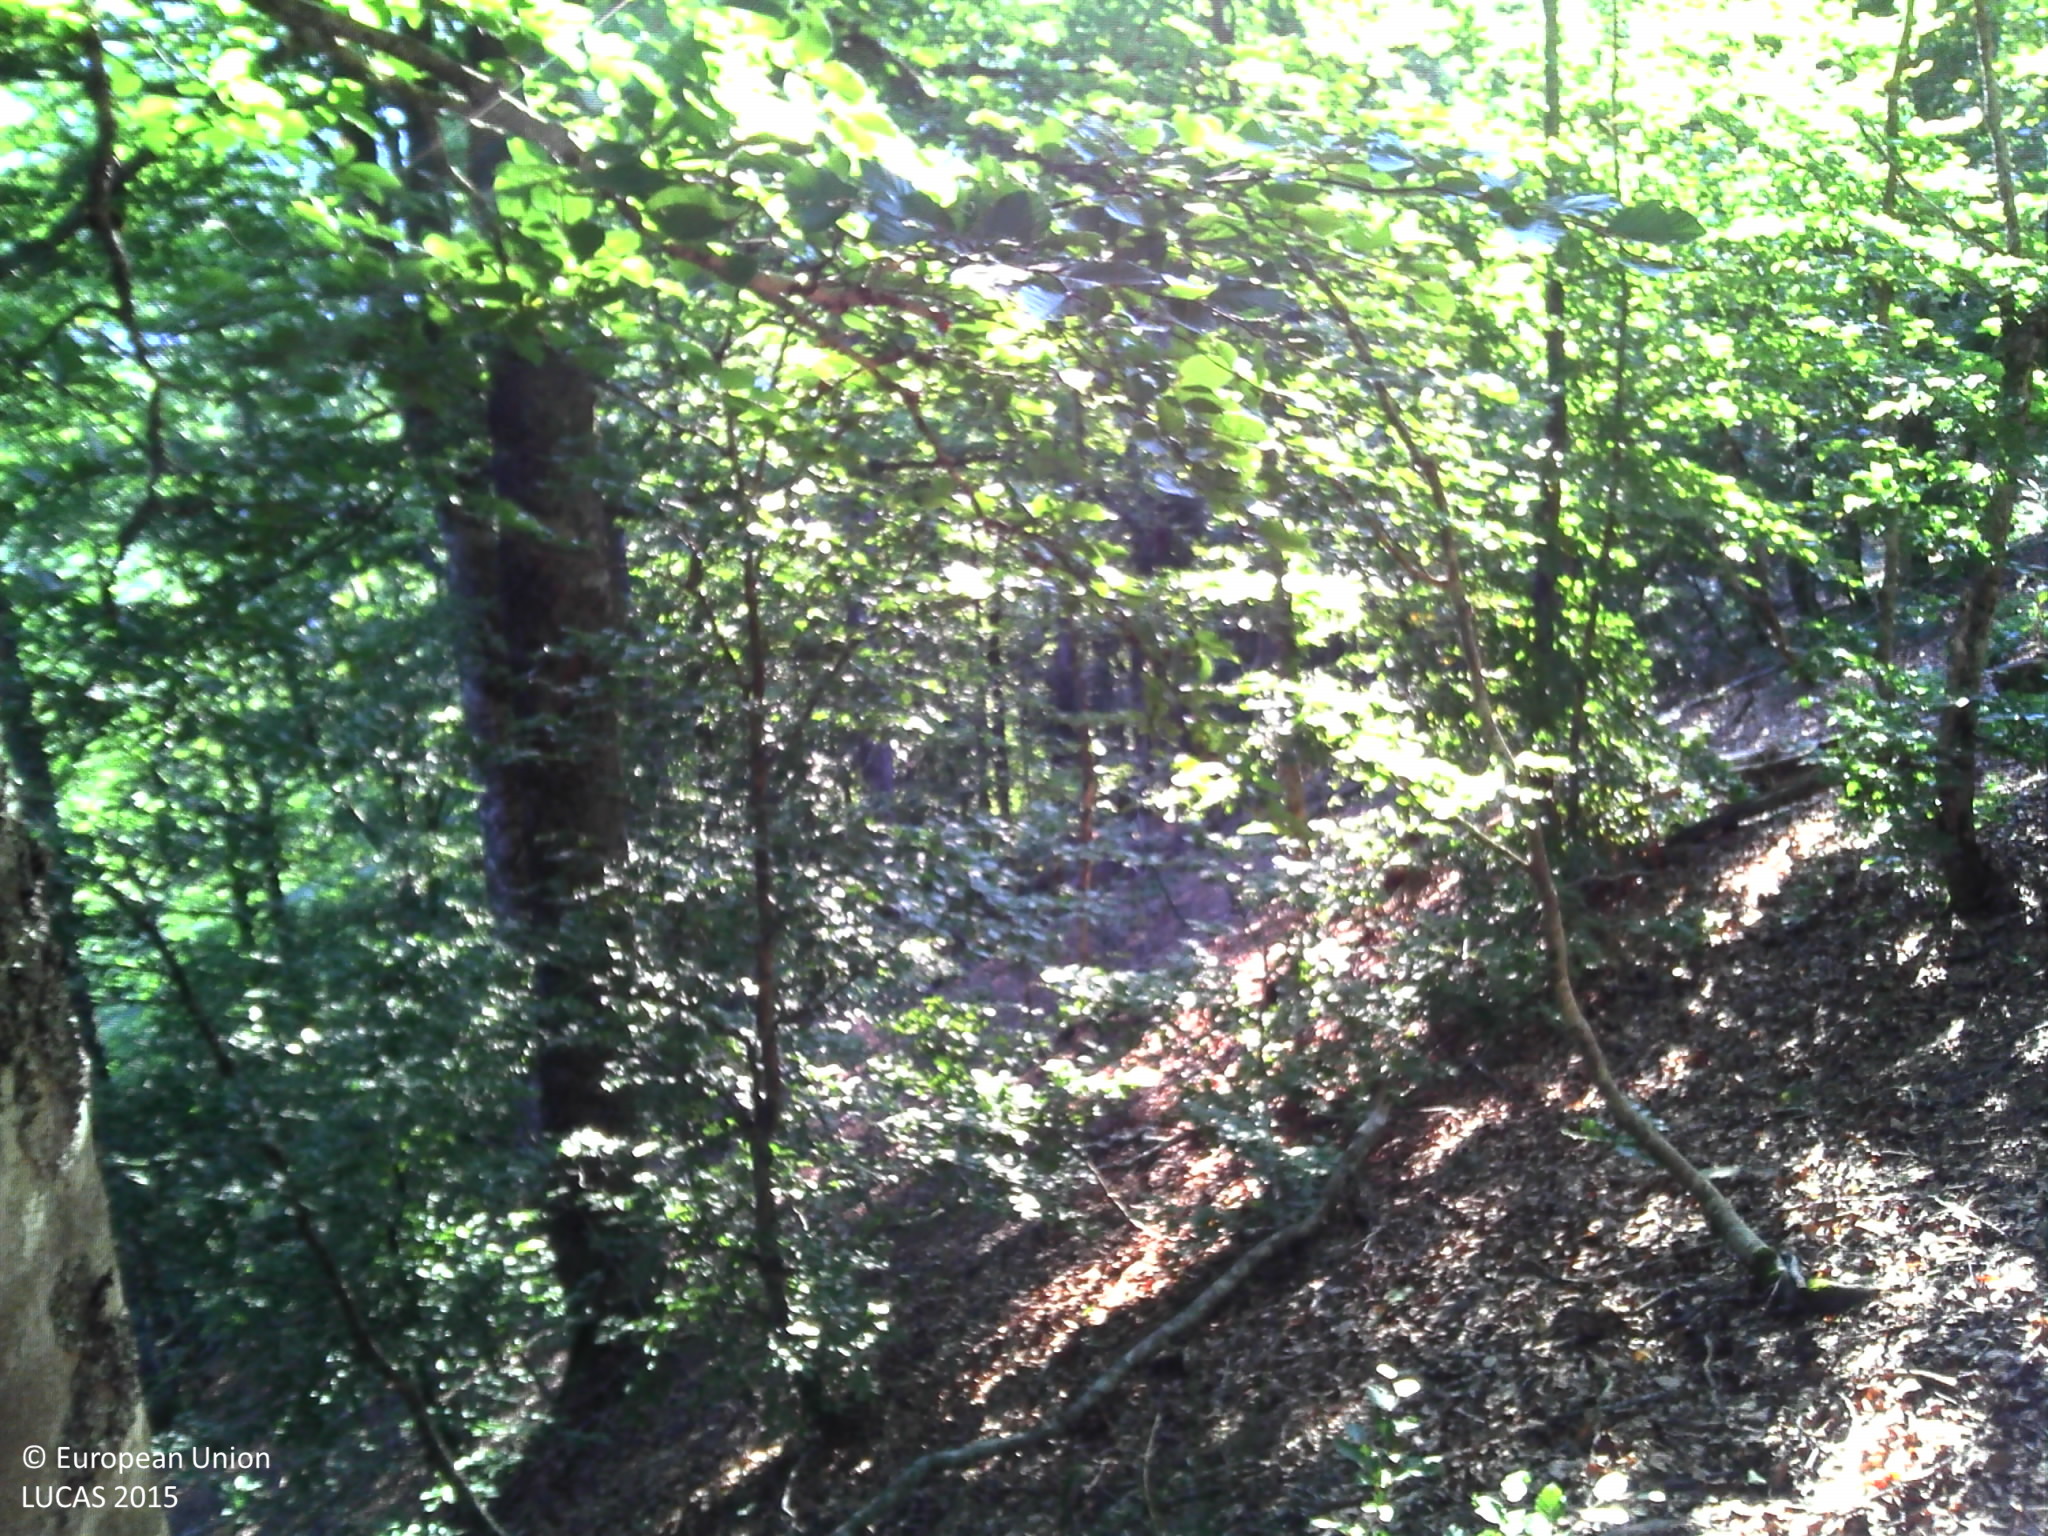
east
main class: Woodland
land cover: Broadleaved woodland
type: beech forest
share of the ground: > 75 %
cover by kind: broadleaved forest trees 90 %, shrubs 5 %, herbaceous plants 5 %
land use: Forestry
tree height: > 5 m
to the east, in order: Broadleaved woodland
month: September
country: FR
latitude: 43.0261
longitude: -1.0925
